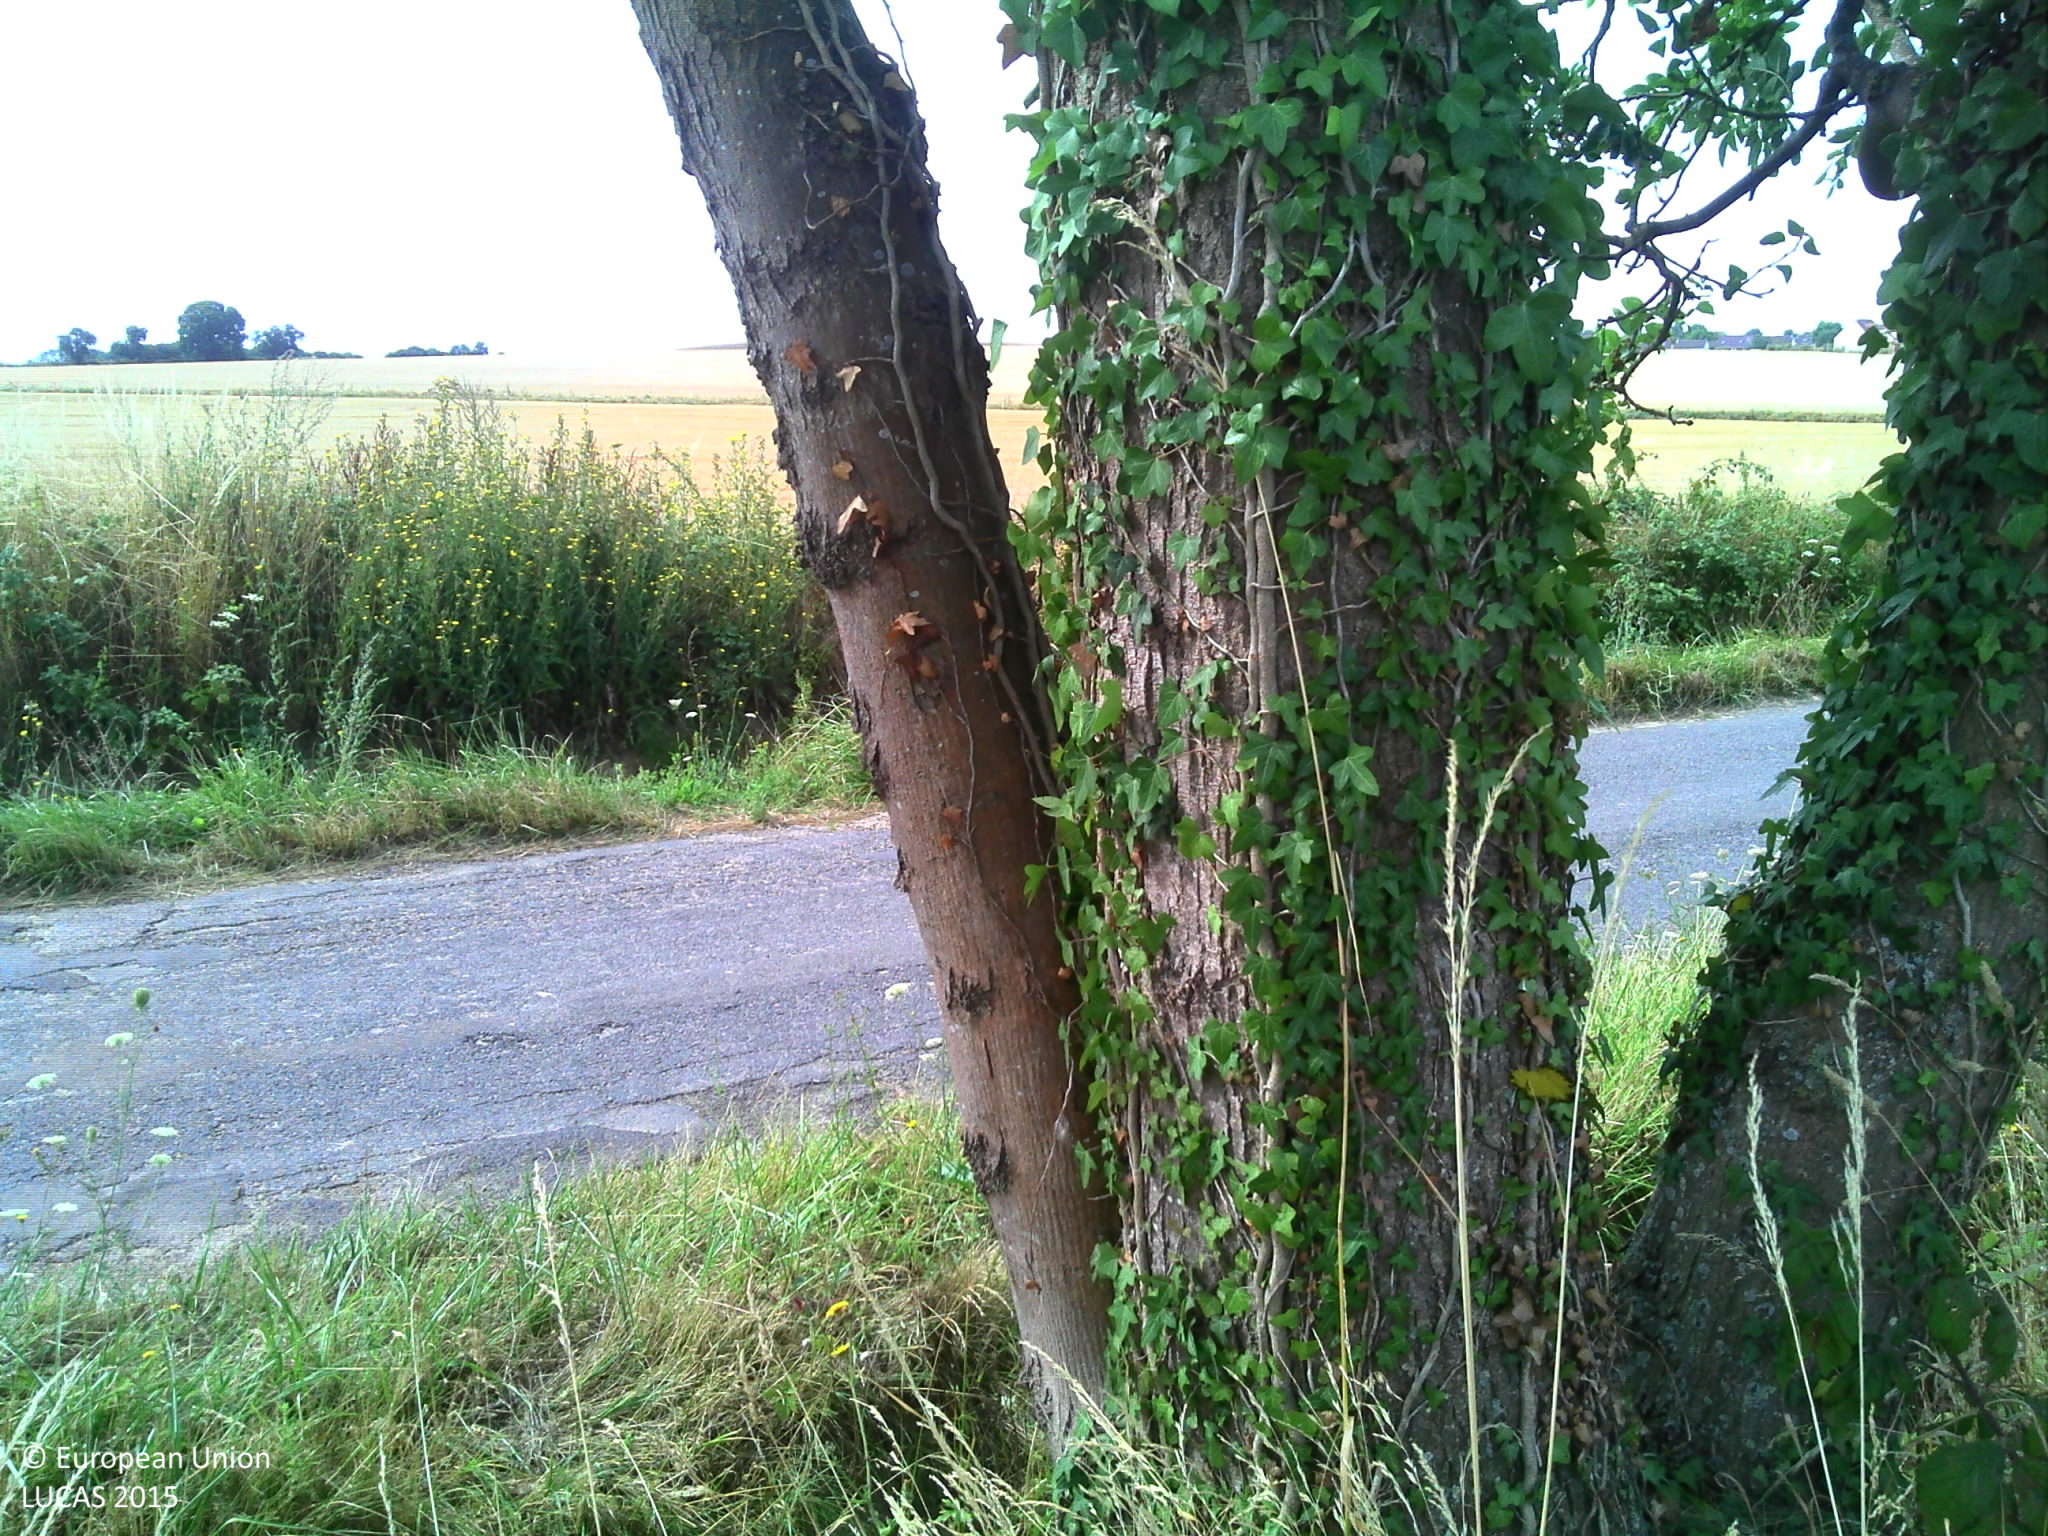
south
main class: Cropland
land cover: Other non-permanent industrial crops
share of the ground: > 75 %
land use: Agriculture (excluding fallow land and kitchen gardens)
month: July
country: FR
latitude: 49.0756
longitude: 2.5828
